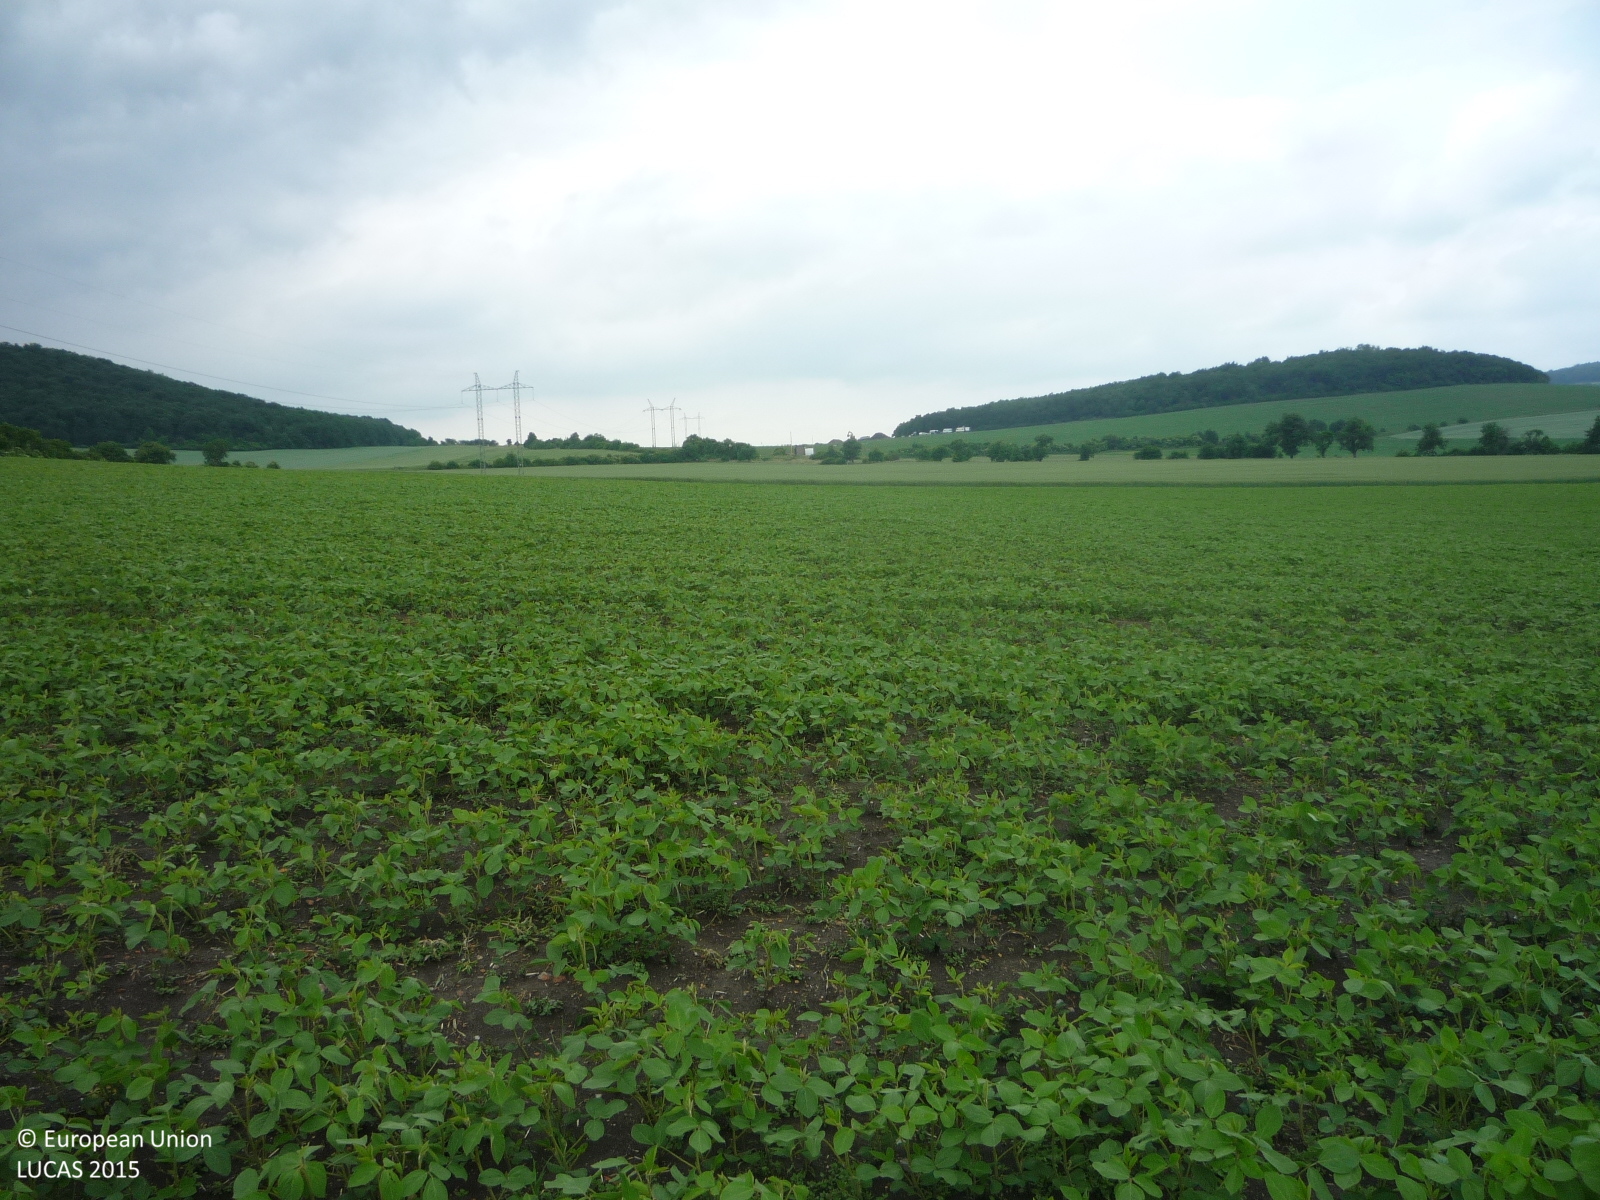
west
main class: Cropland
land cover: Soya
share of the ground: > 75 %
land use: Agriculture (excluding fallow land and kitchen gardens)
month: June
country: CZ
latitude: 50.3896
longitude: 13.8406
